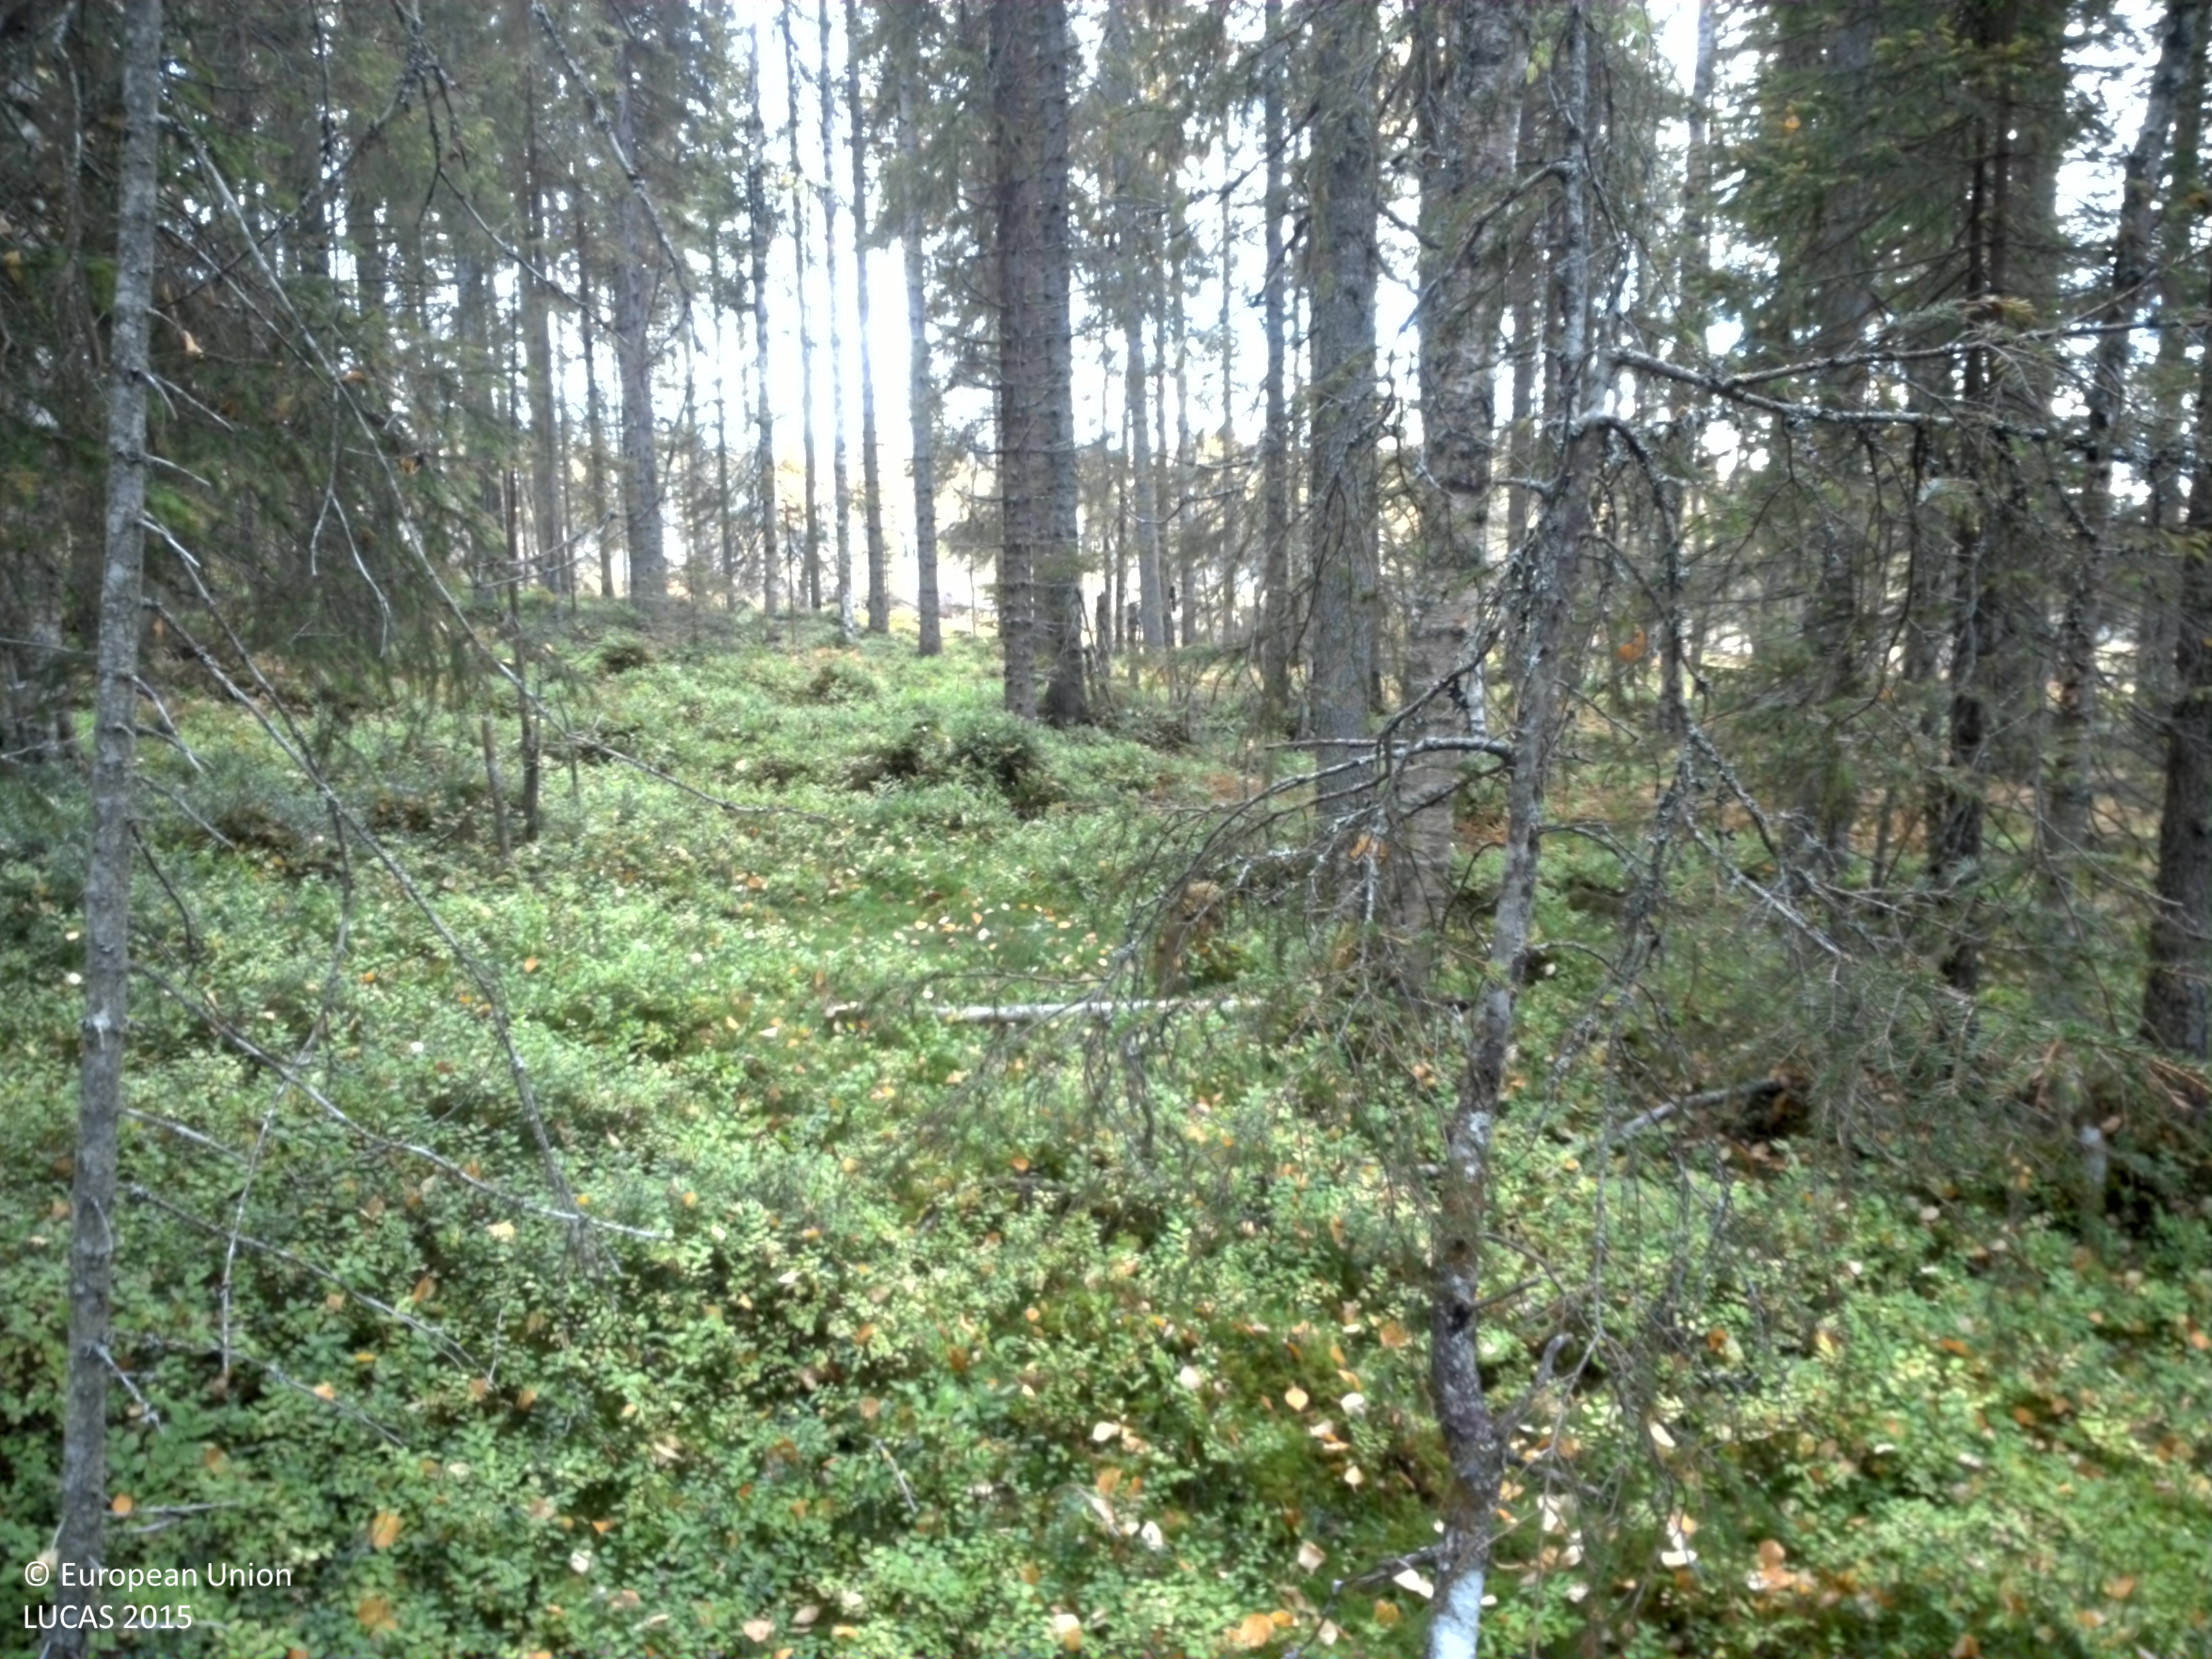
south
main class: Woodland
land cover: Spruce dominated mixed woodland
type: boreal forest
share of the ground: 50 - 75 %
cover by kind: coniferous forest trees 35 %, shrubs 20 %, herbaceous plants 20 %, broadleaved forest trees 15 %, lichens and mosses 10 %
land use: Forestry
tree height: > 5 m
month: September
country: SE
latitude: 65.1215
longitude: 17.6532
